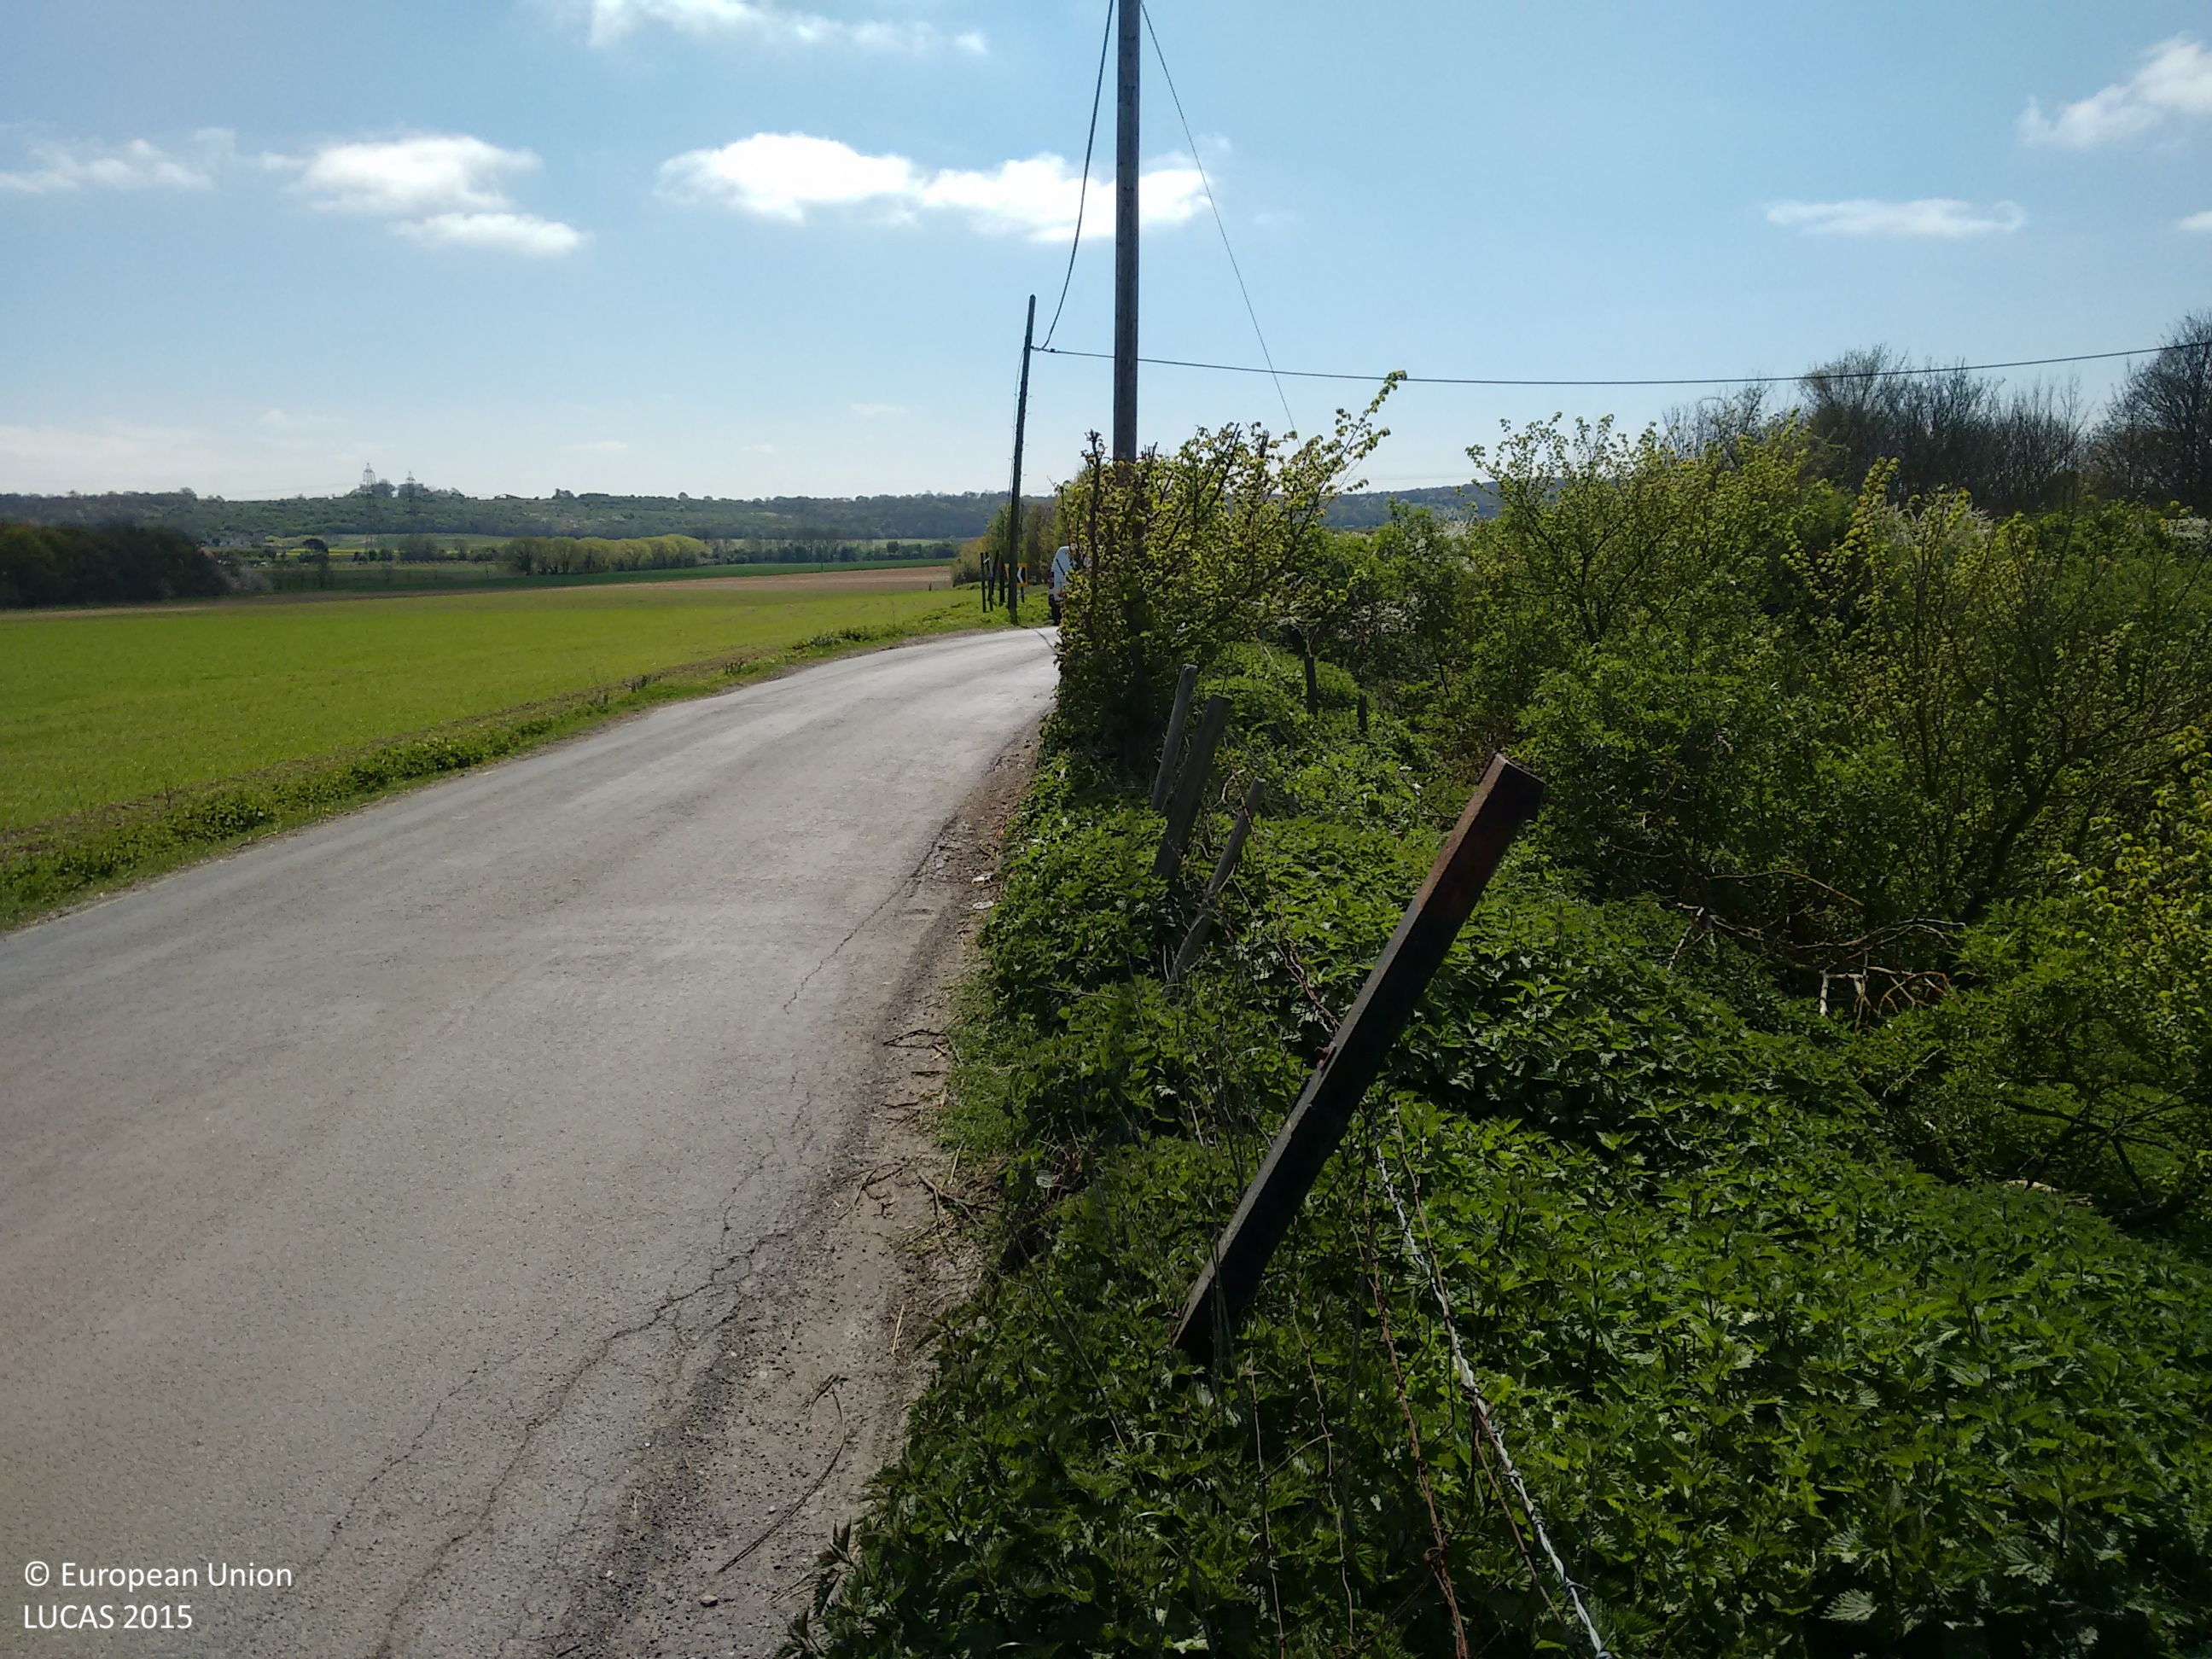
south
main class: Grassland
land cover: Grassland without tree/shrub cover
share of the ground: > 75 %
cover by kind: herbaceous plants 80 %, unconsolidated bare surface 20 %
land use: Agriculture (excluding fallow land and kitchen gardens)
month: April
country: GB
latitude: 51.4540
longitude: 0.5174
